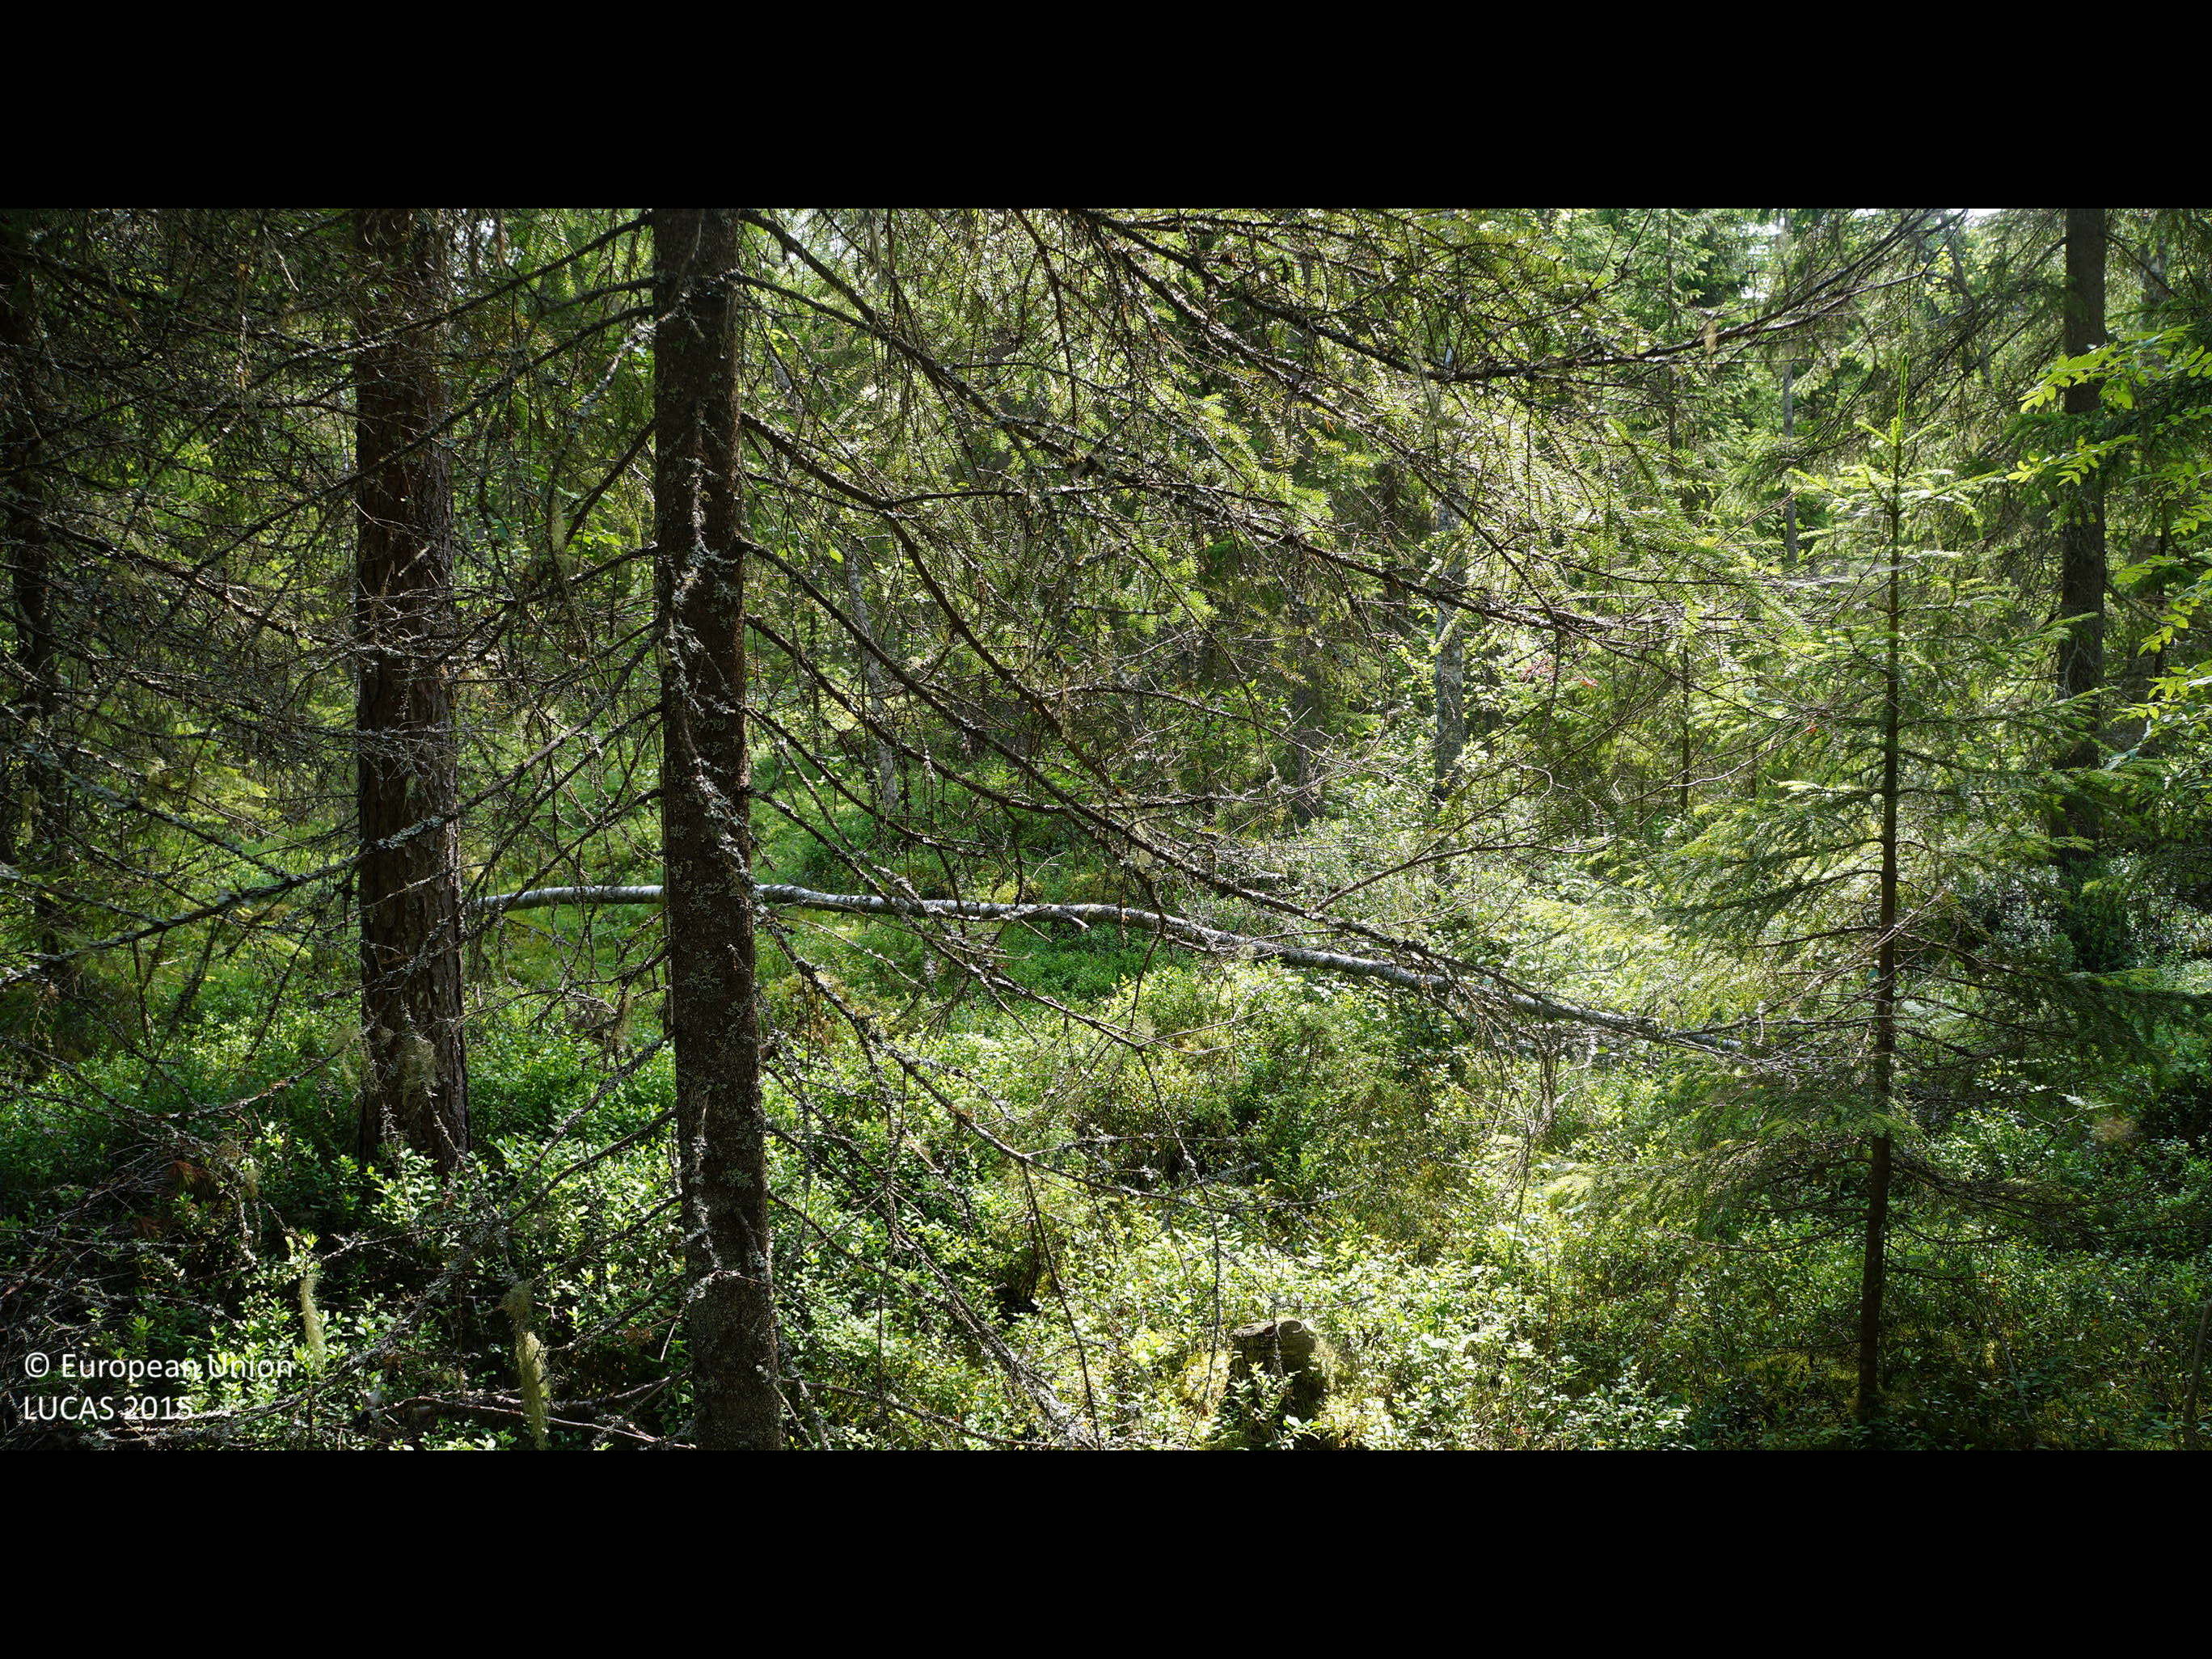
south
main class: Woodland
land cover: Spruce dominated coniferous woodland
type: boreal forest
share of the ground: > 75 %
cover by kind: coniferous forest trees 70 %, shrubs 20 %, broadleaved forest trees 5 %, lichens and mosses 5 %
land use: Forestry
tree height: > 5 m
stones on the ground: < 10 %
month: July
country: FI
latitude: 64.1924
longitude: 24.2527
